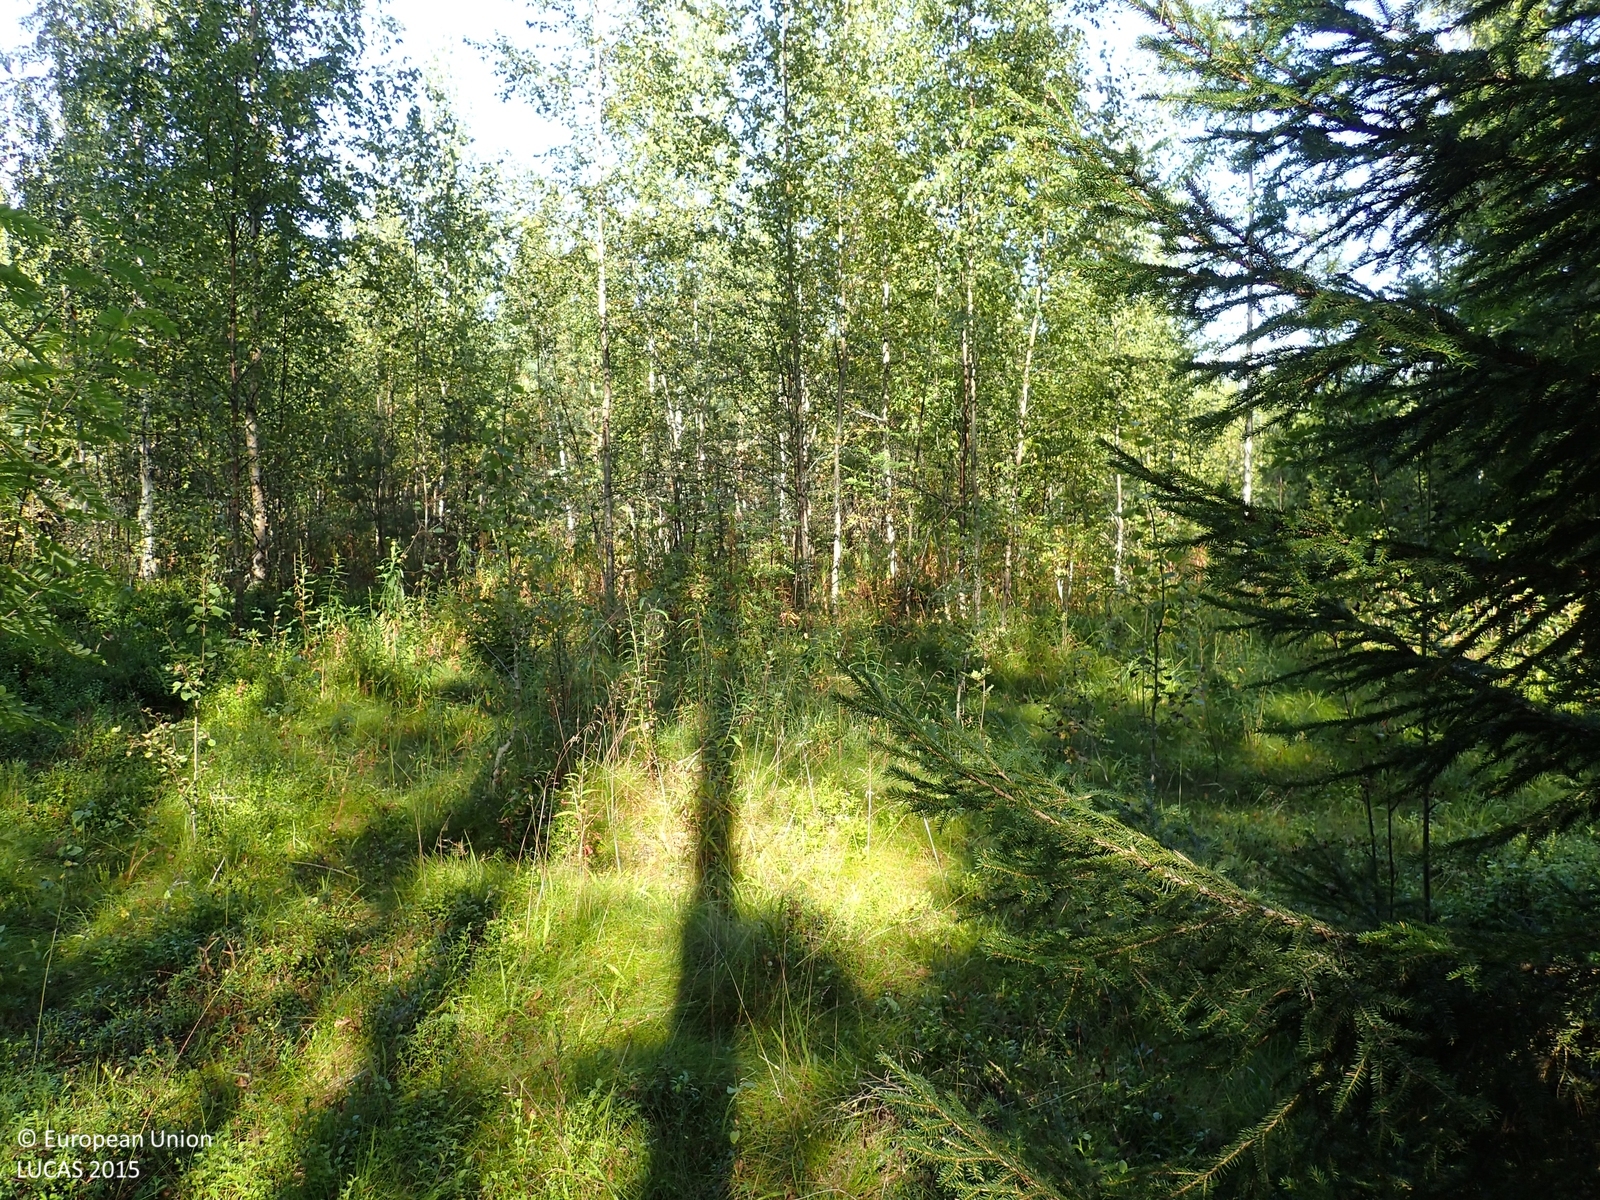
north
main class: Woodland
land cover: Pine dominated coniferous woodland
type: boreal forest
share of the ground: > 75 %
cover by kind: coniferous forest trees 70 %, shrubs 20 %, broadleaved forest trees 5 %, herbaceous plants 5 %
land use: Forestry
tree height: > 5 m
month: August
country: FI
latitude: 62.5863
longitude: 21.7856
